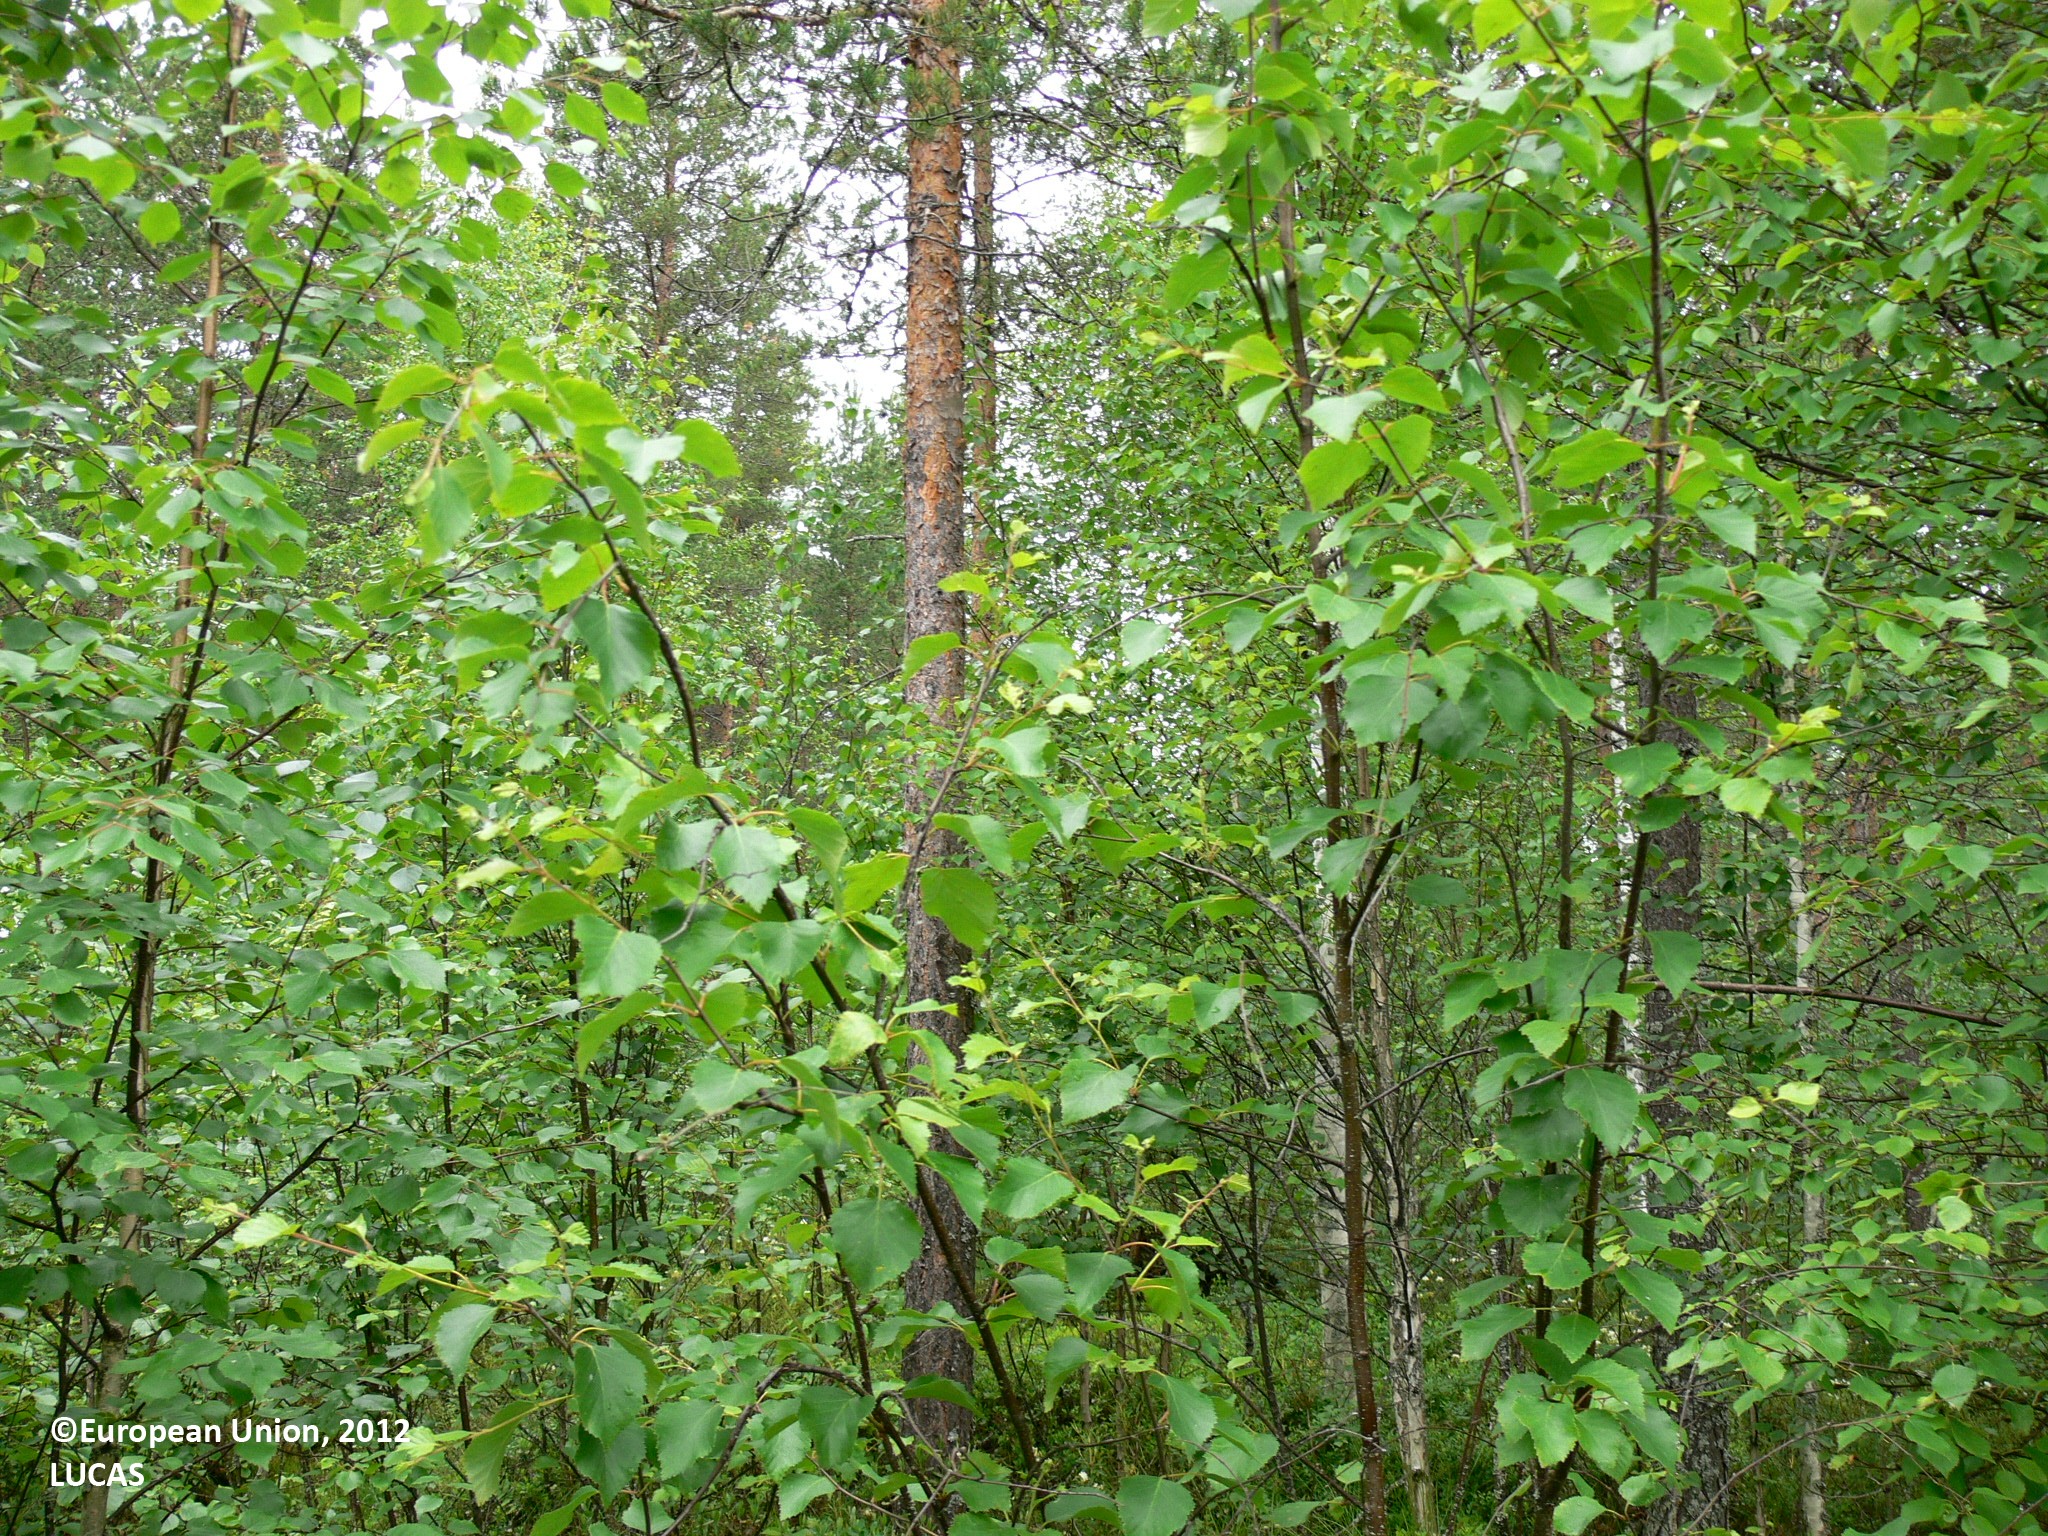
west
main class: Woodland
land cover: Pine dominated mixed woodland
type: boreal forest
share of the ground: 50 - 75 %
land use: Forestry
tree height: > 5 m
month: June
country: FI
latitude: 62.9323
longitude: 29.4374
